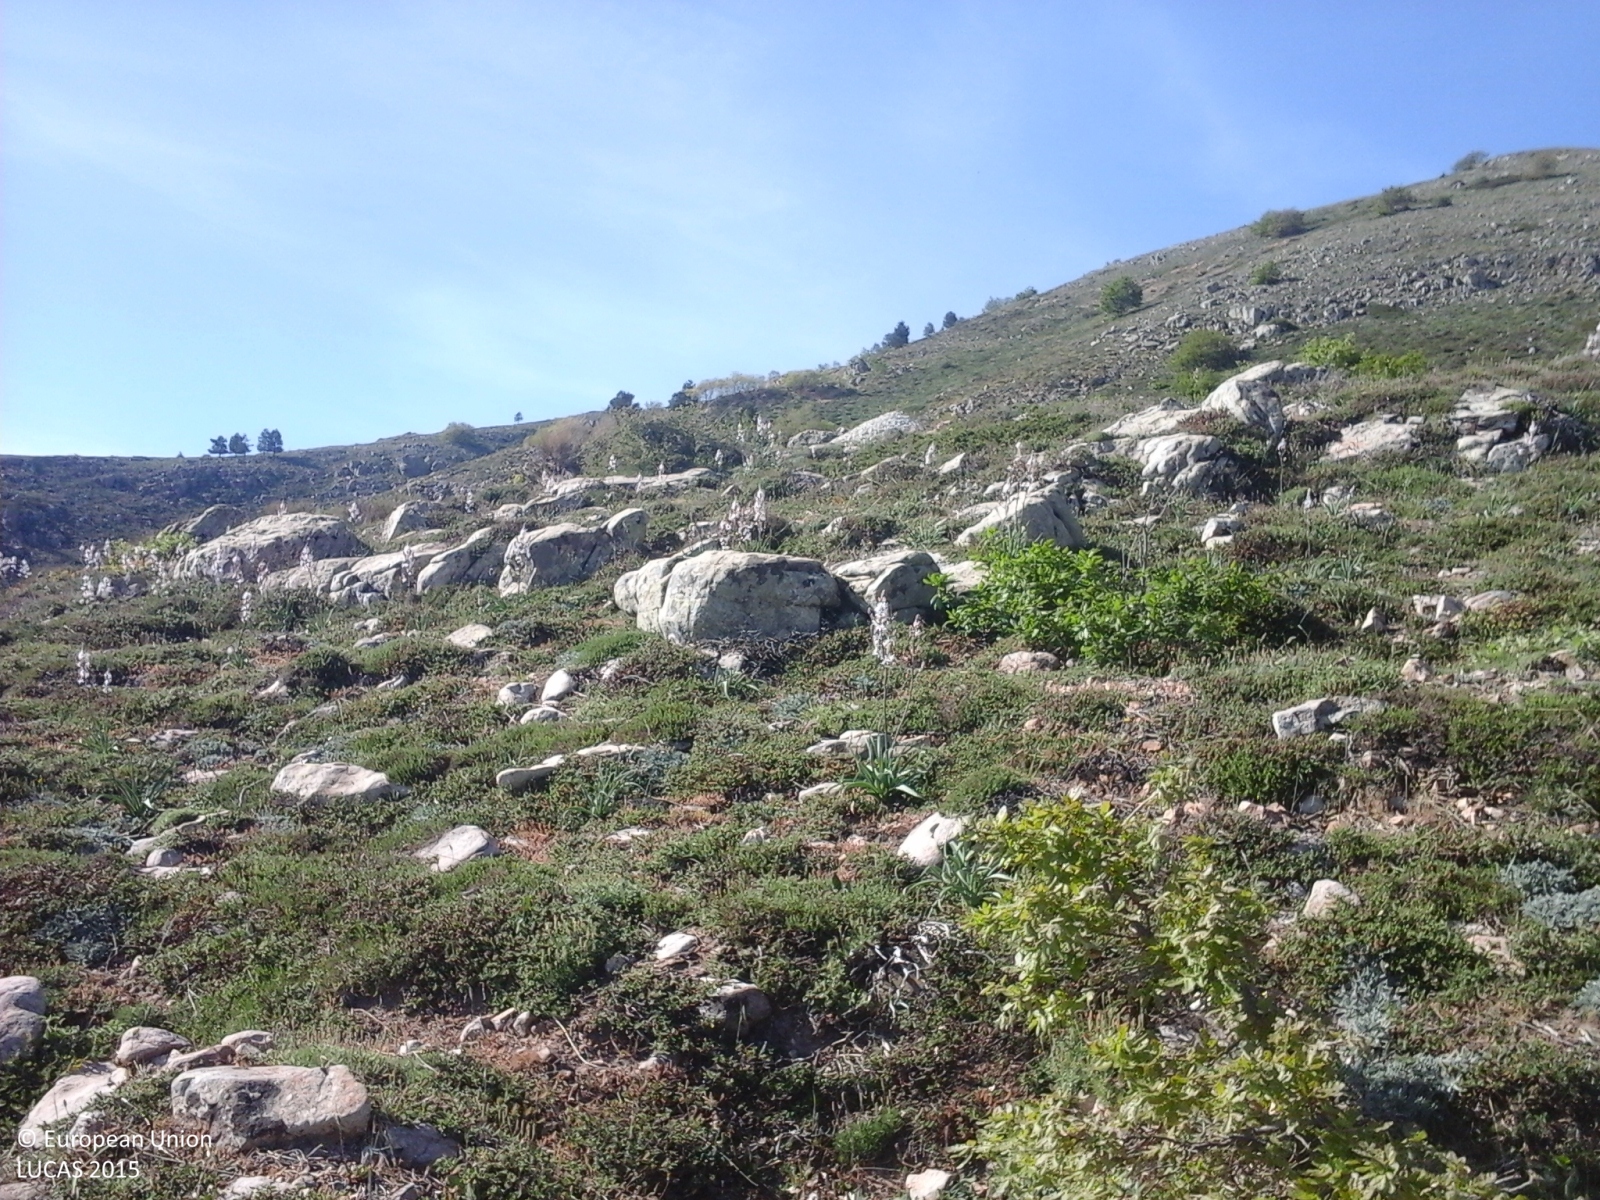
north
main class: Shrubland
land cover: Shrubland with sparse tree cover
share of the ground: > 75 %
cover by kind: shrubs 45 %, herbaceous plants 30 %, consolidated bare surface 15 %, broadleaved forest trees 5 %, unconsolidated bare surface 5 %
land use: Agriculture (excluding fallow land and kitchen gardens)
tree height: < 5 m
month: May
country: IT
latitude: 37.8248
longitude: 14.0497
